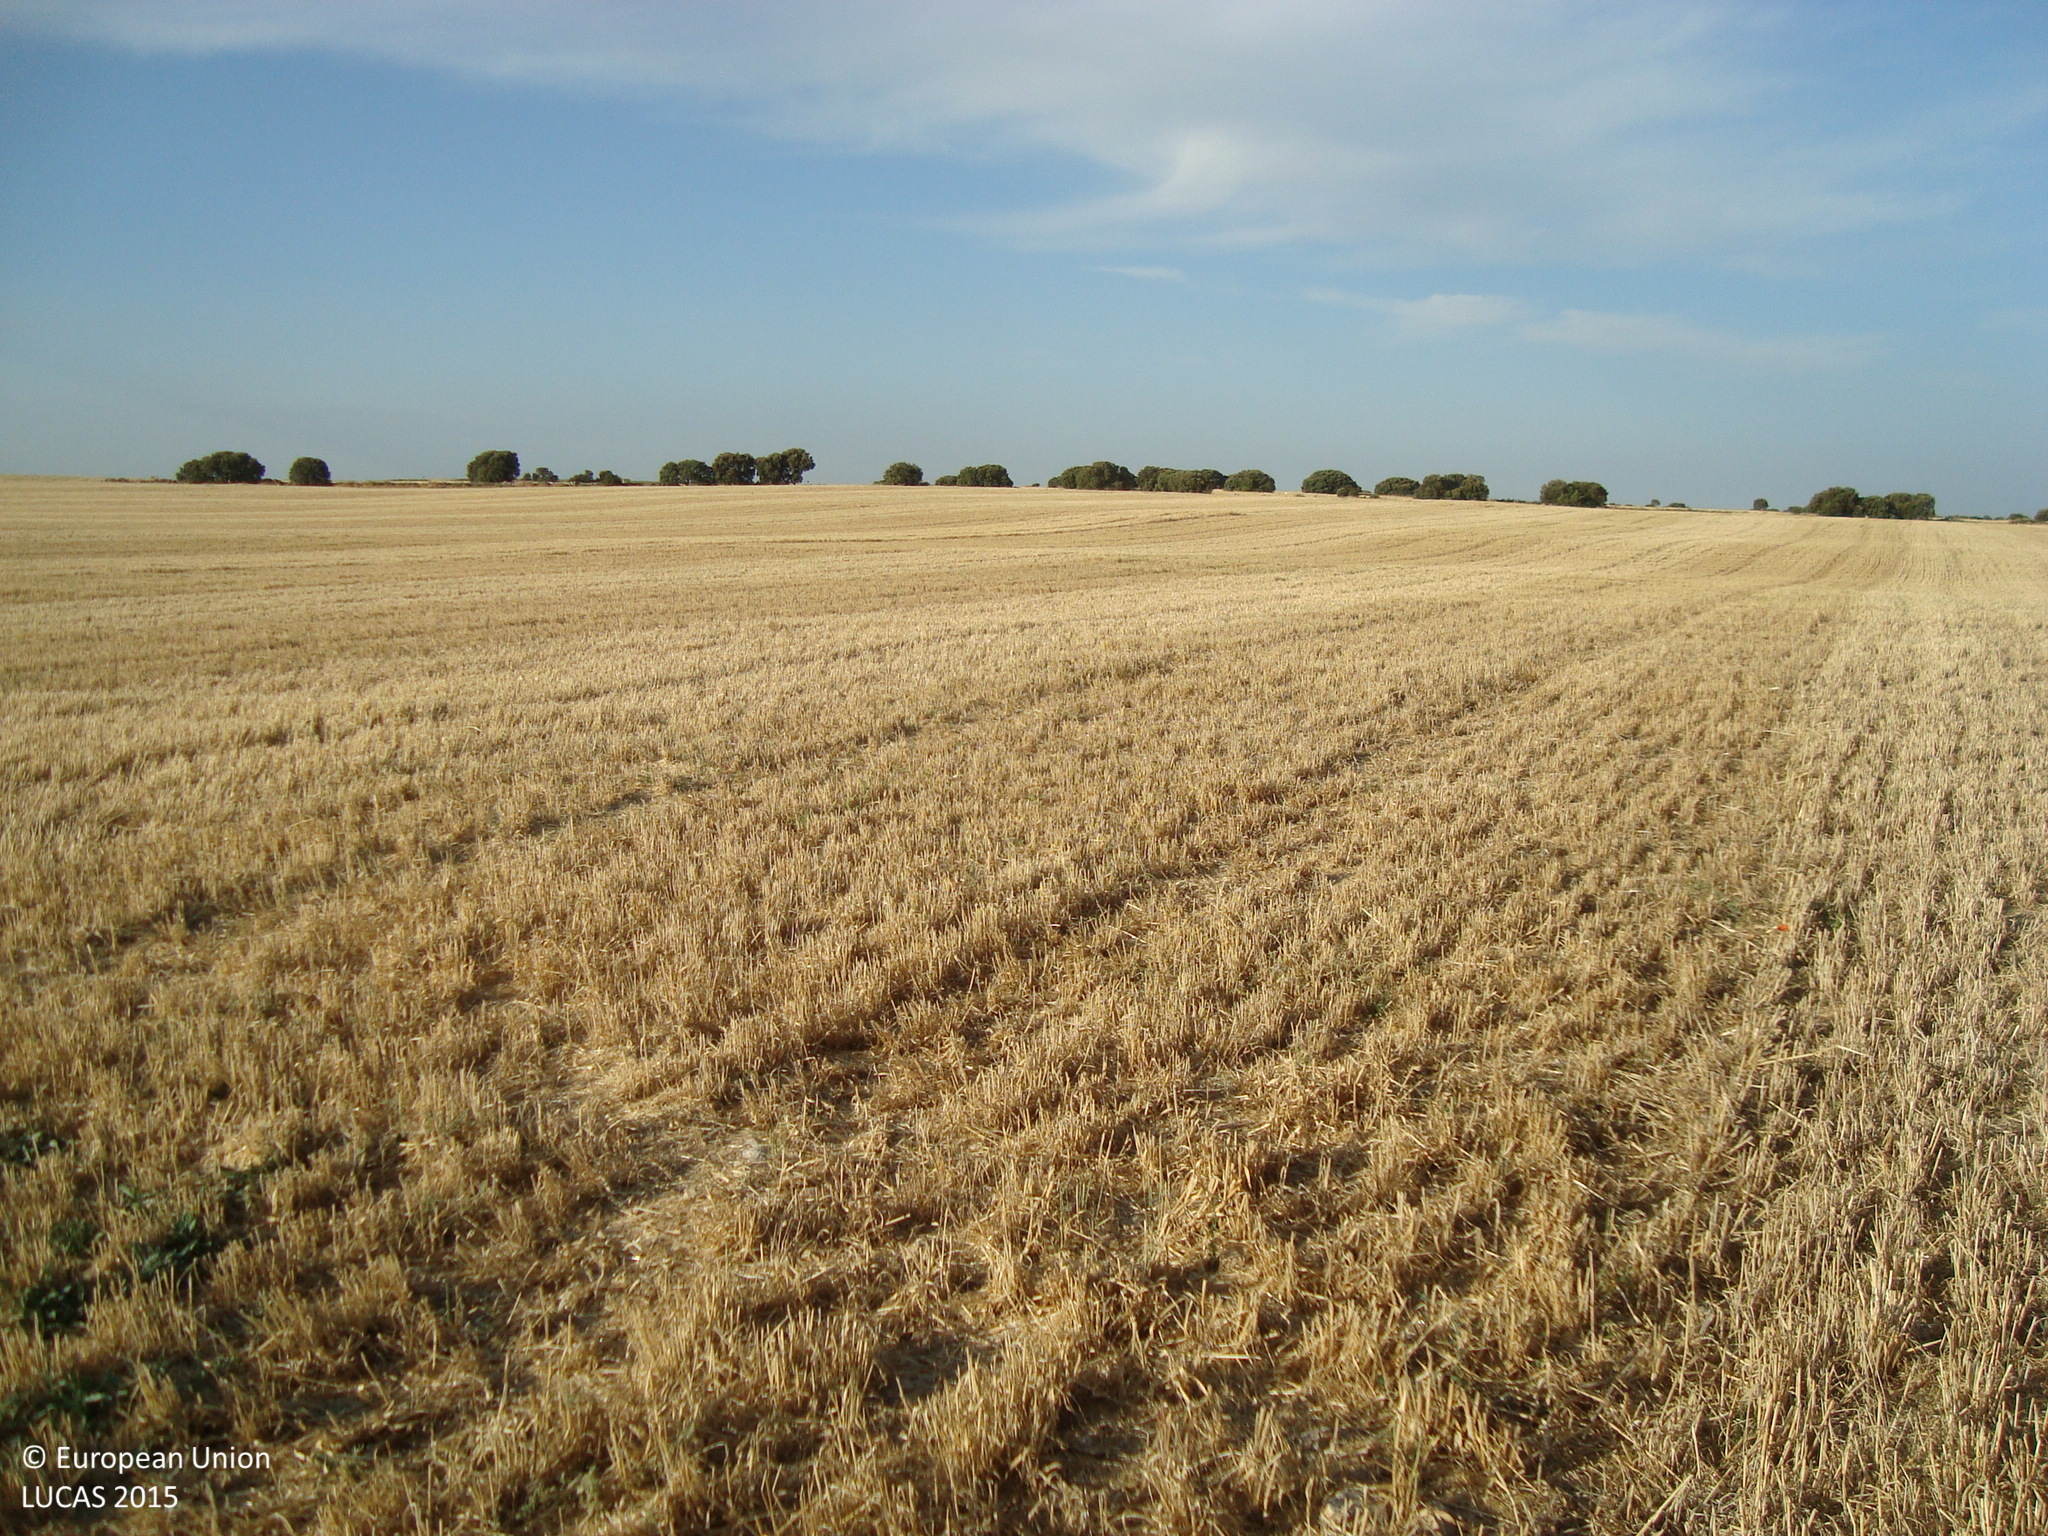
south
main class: Cropland
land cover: Barley
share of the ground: > 75 %
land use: Agriculture (excluding fallow land and kitchen gardens)
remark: Harvested field
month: July
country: ES
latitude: 41.8935
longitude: -4.2746
